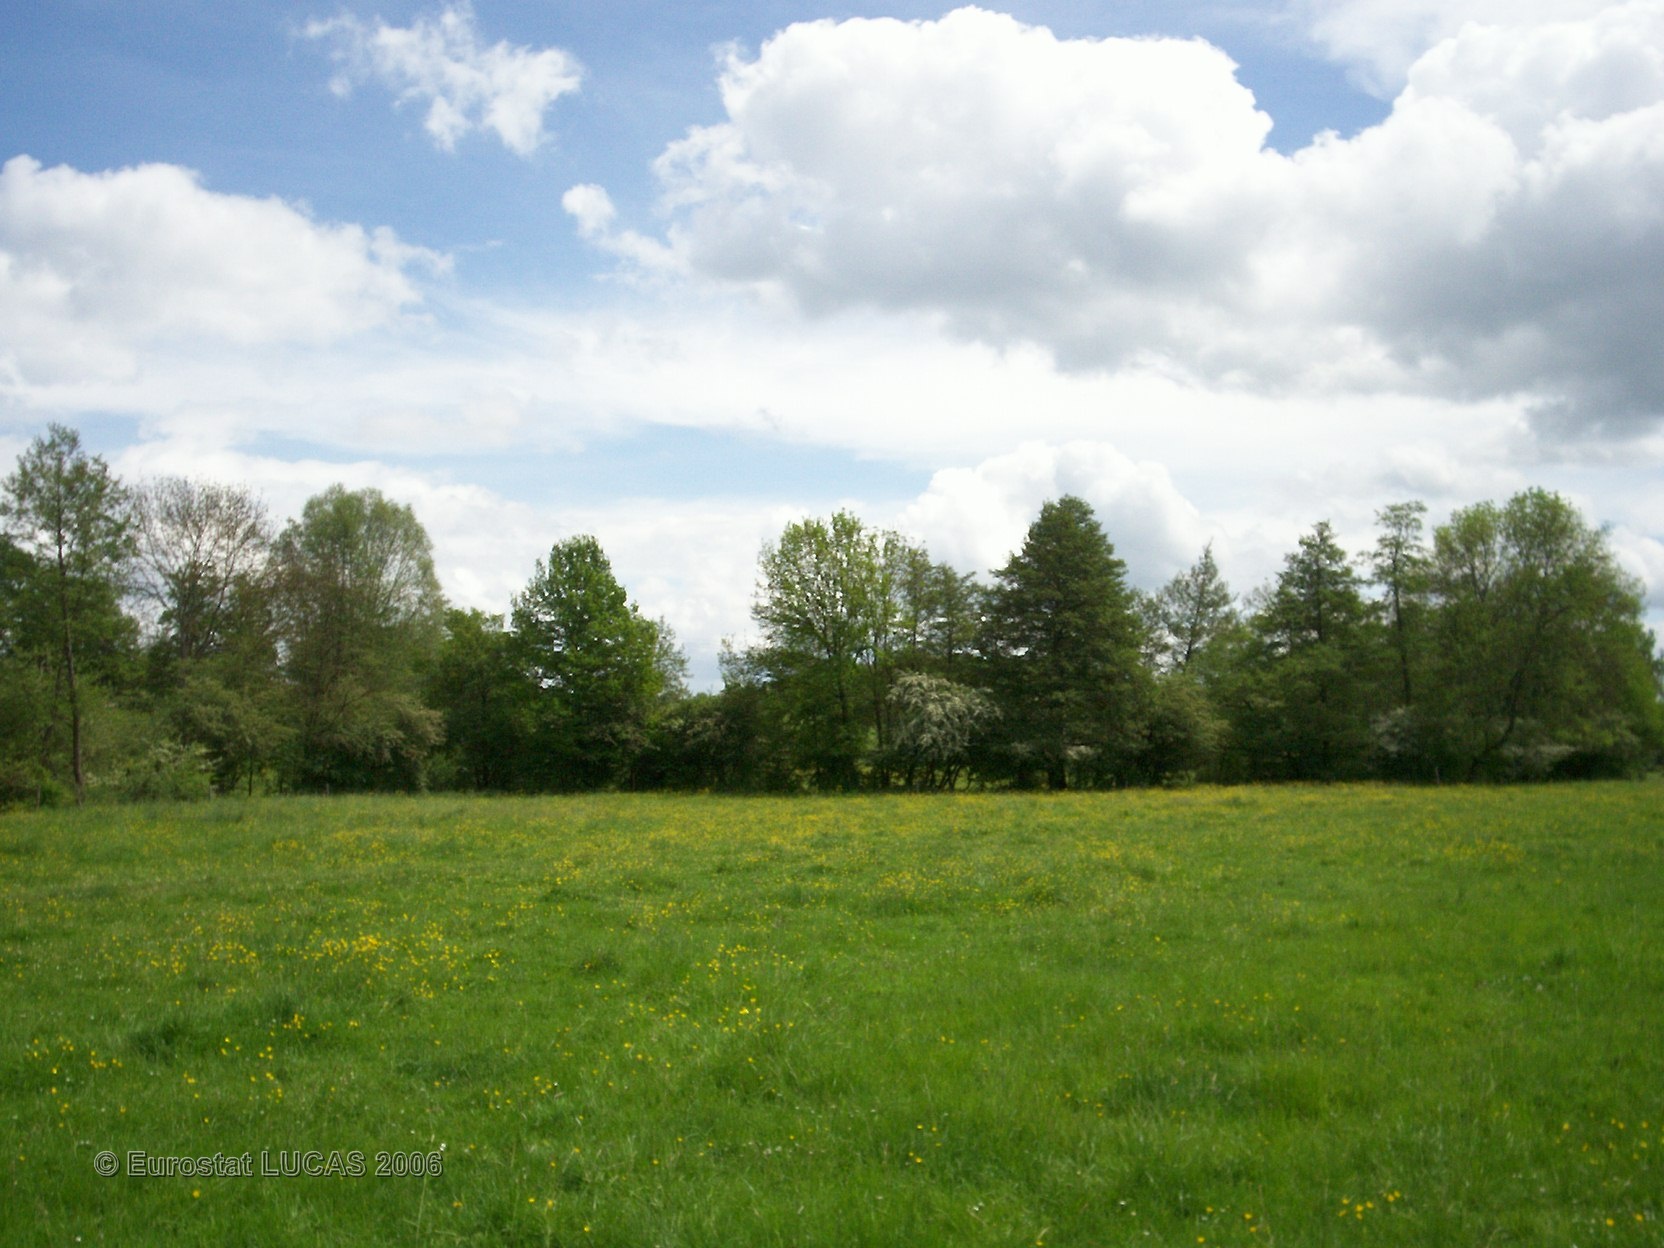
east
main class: Grassland
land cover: Grassland without tree/shrub cover
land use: Agriculture (excluding fallow land and kitchen gardens)
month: May
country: FR
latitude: 46.1183
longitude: 4.1397
